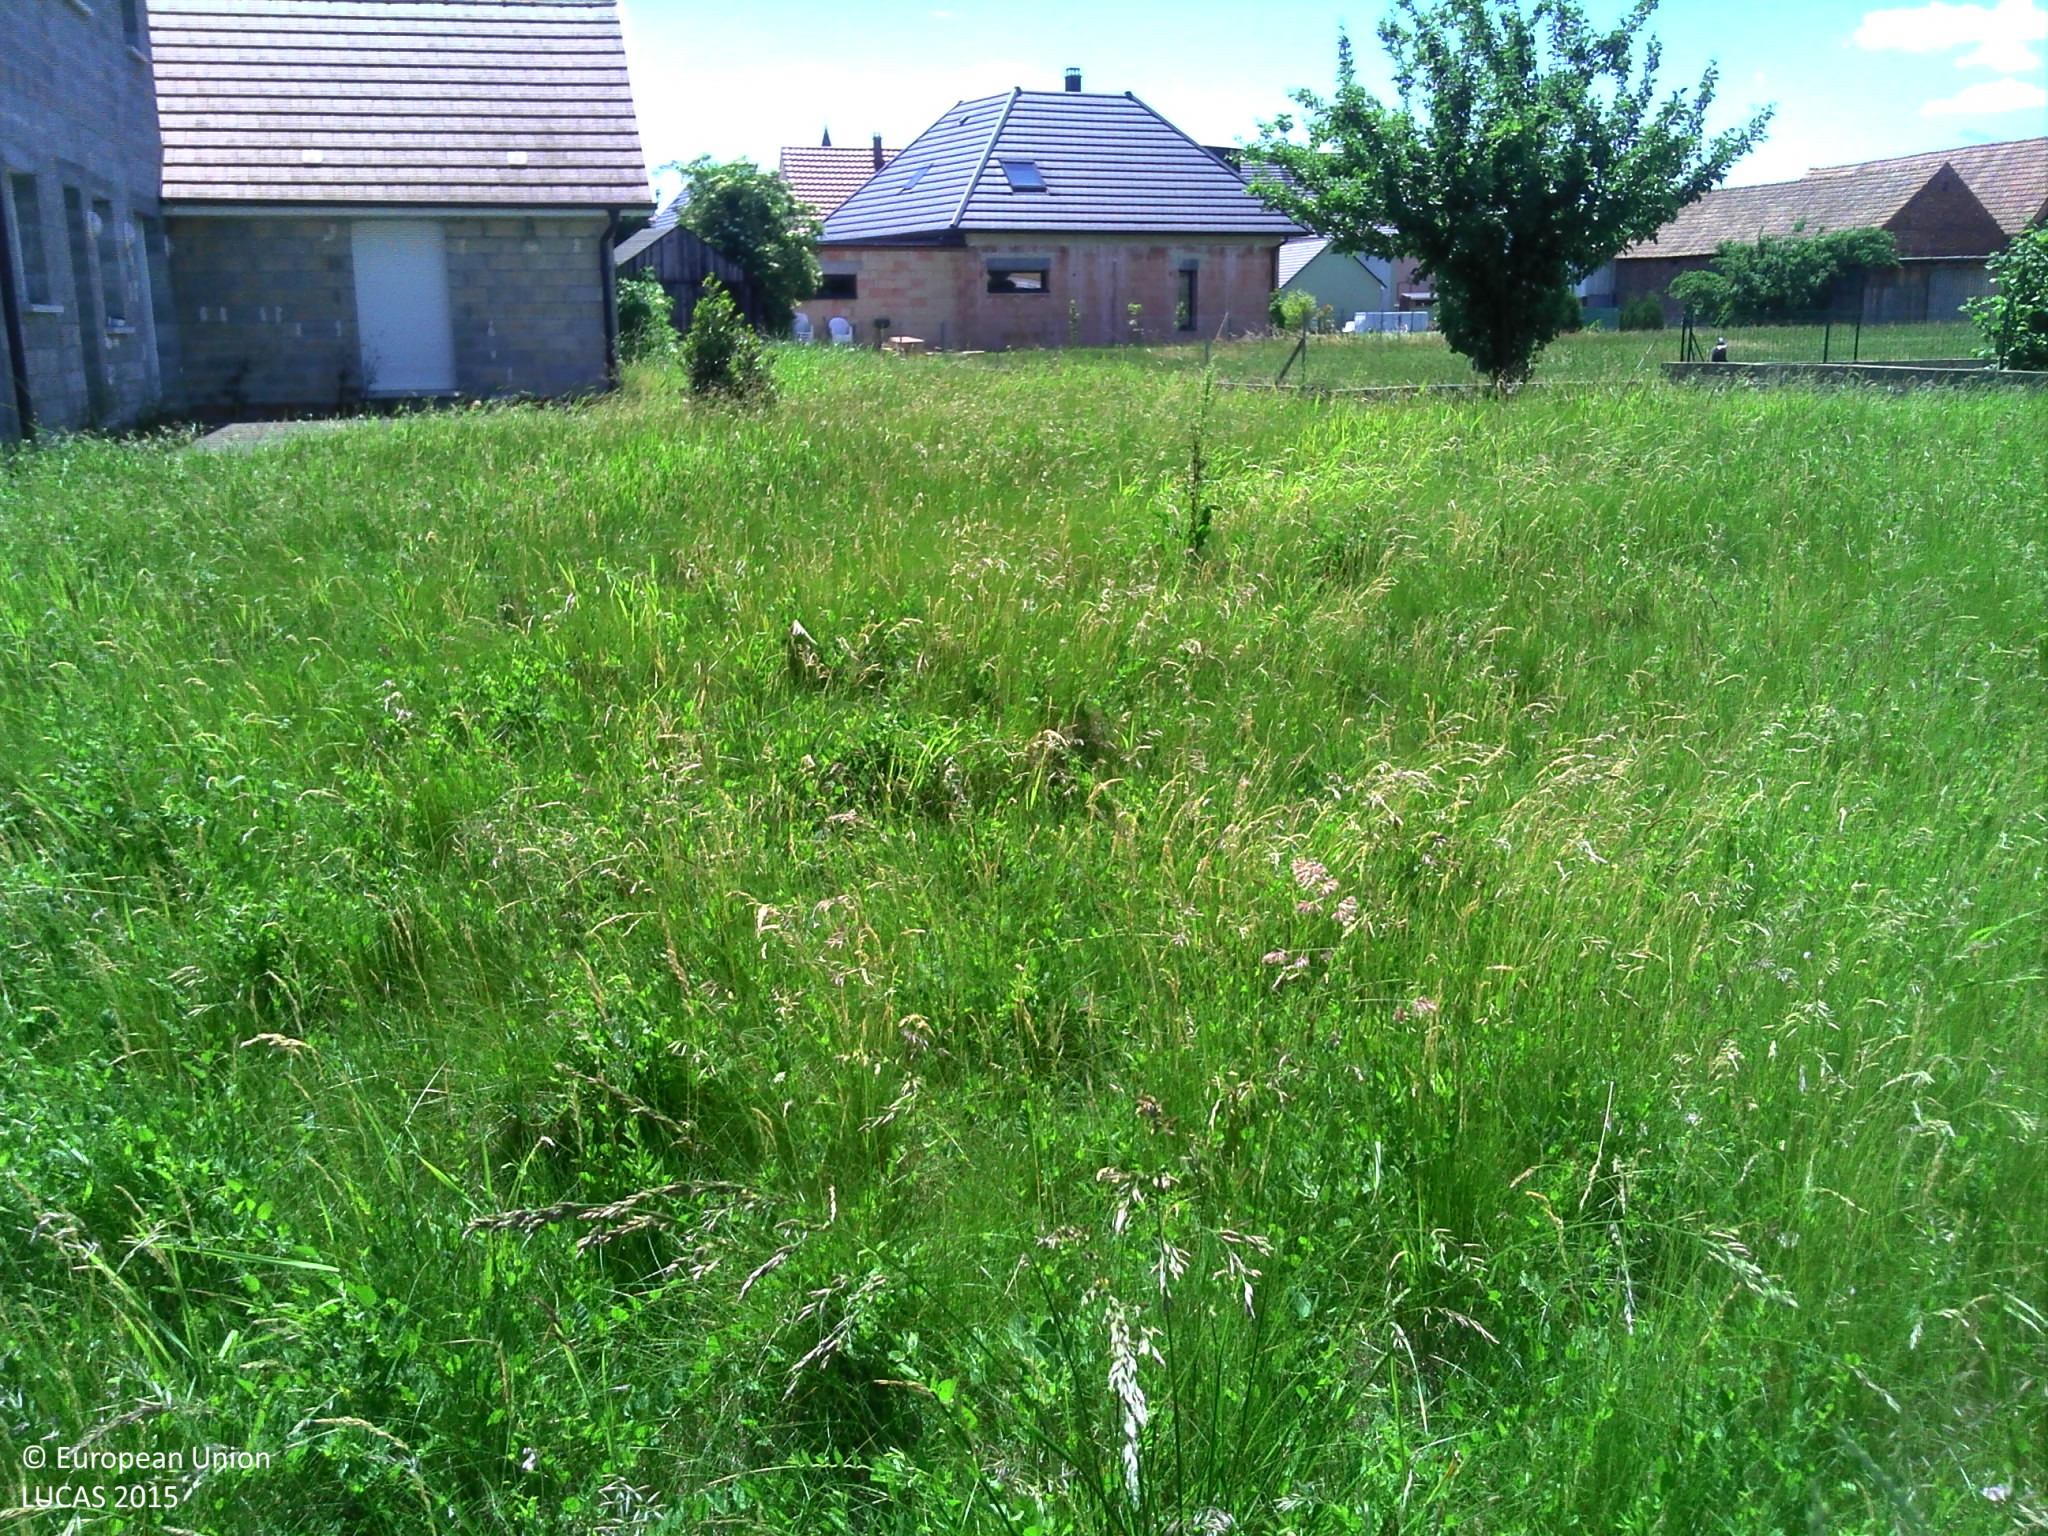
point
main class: Grassland
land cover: Grassland with sparse tree/shrub cover
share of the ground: > 75 %
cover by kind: herbaceous plants 95 %, broadleaved forest trees 5 %
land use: Residential
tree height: < 5 m
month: June
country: FR
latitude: 47.9586
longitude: 7.3898
